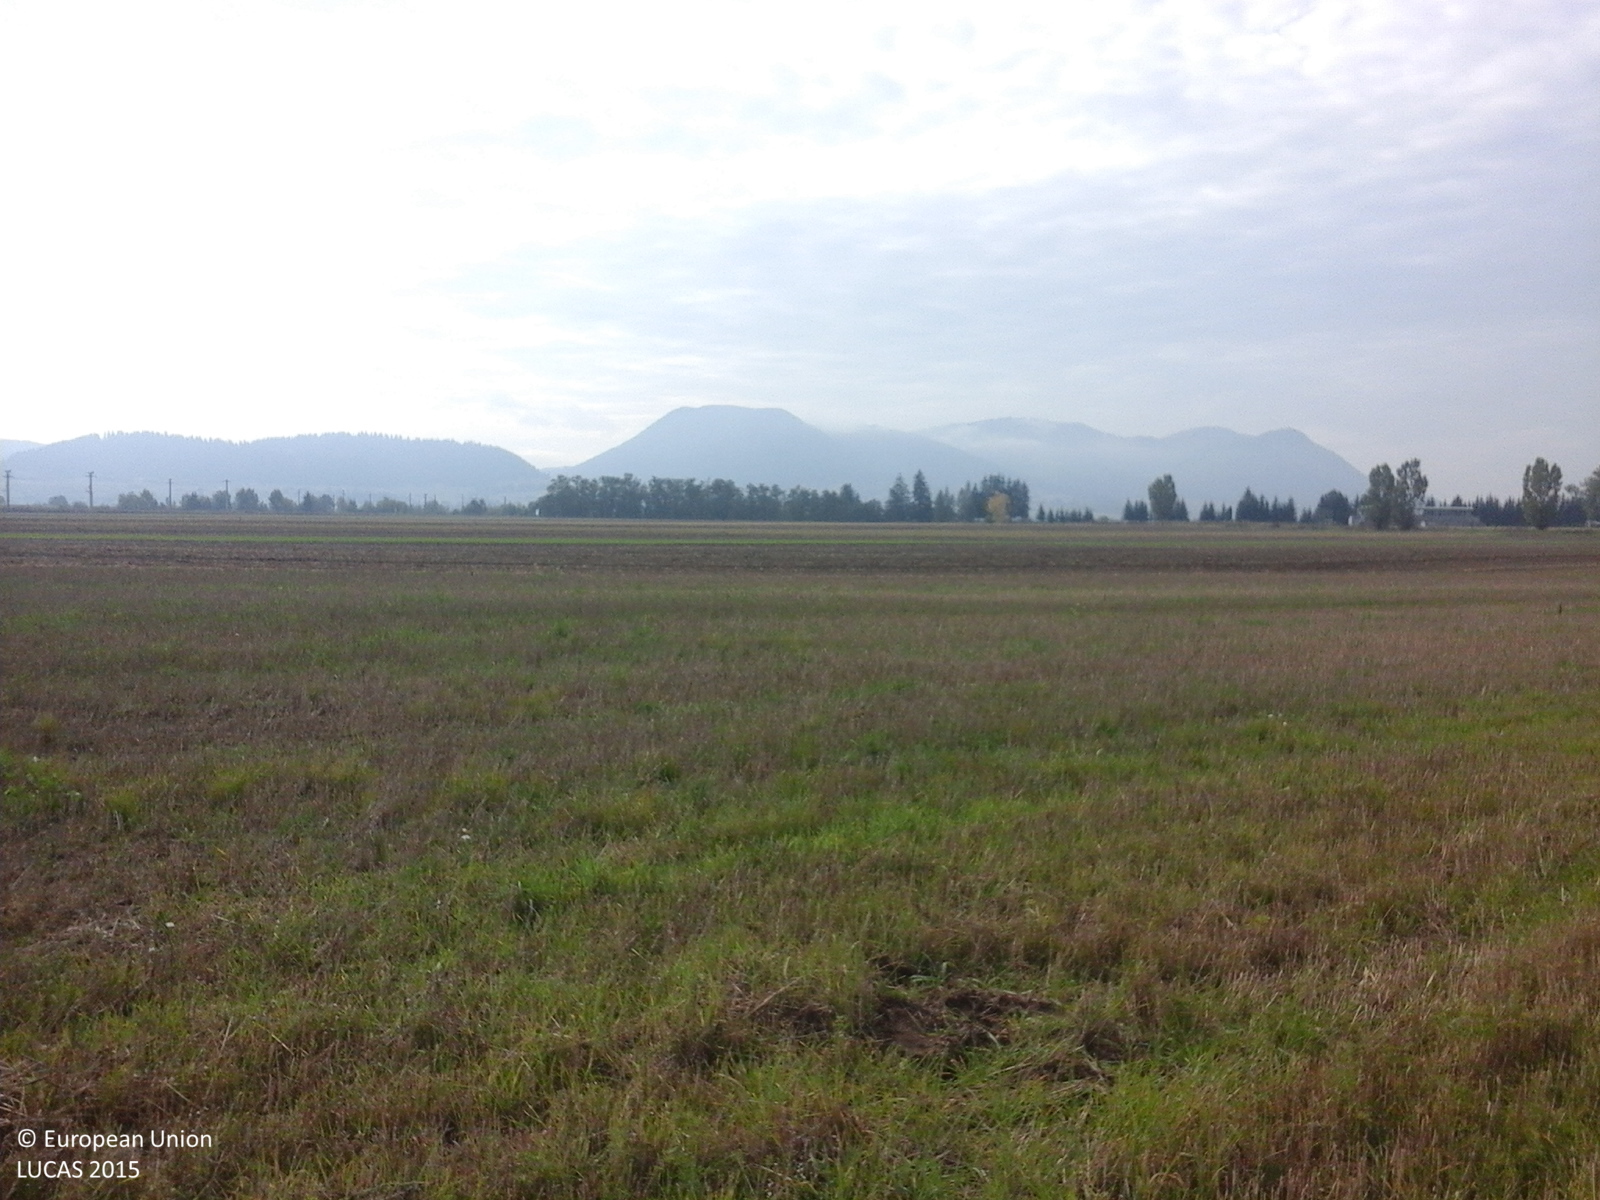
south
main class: Cropland
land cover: Common wheat
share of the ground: > 75 %
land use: Agriculture (excluding fallow land and kitchen gardens)
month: October
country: RO
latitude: 46.2135
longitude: 25.9179
